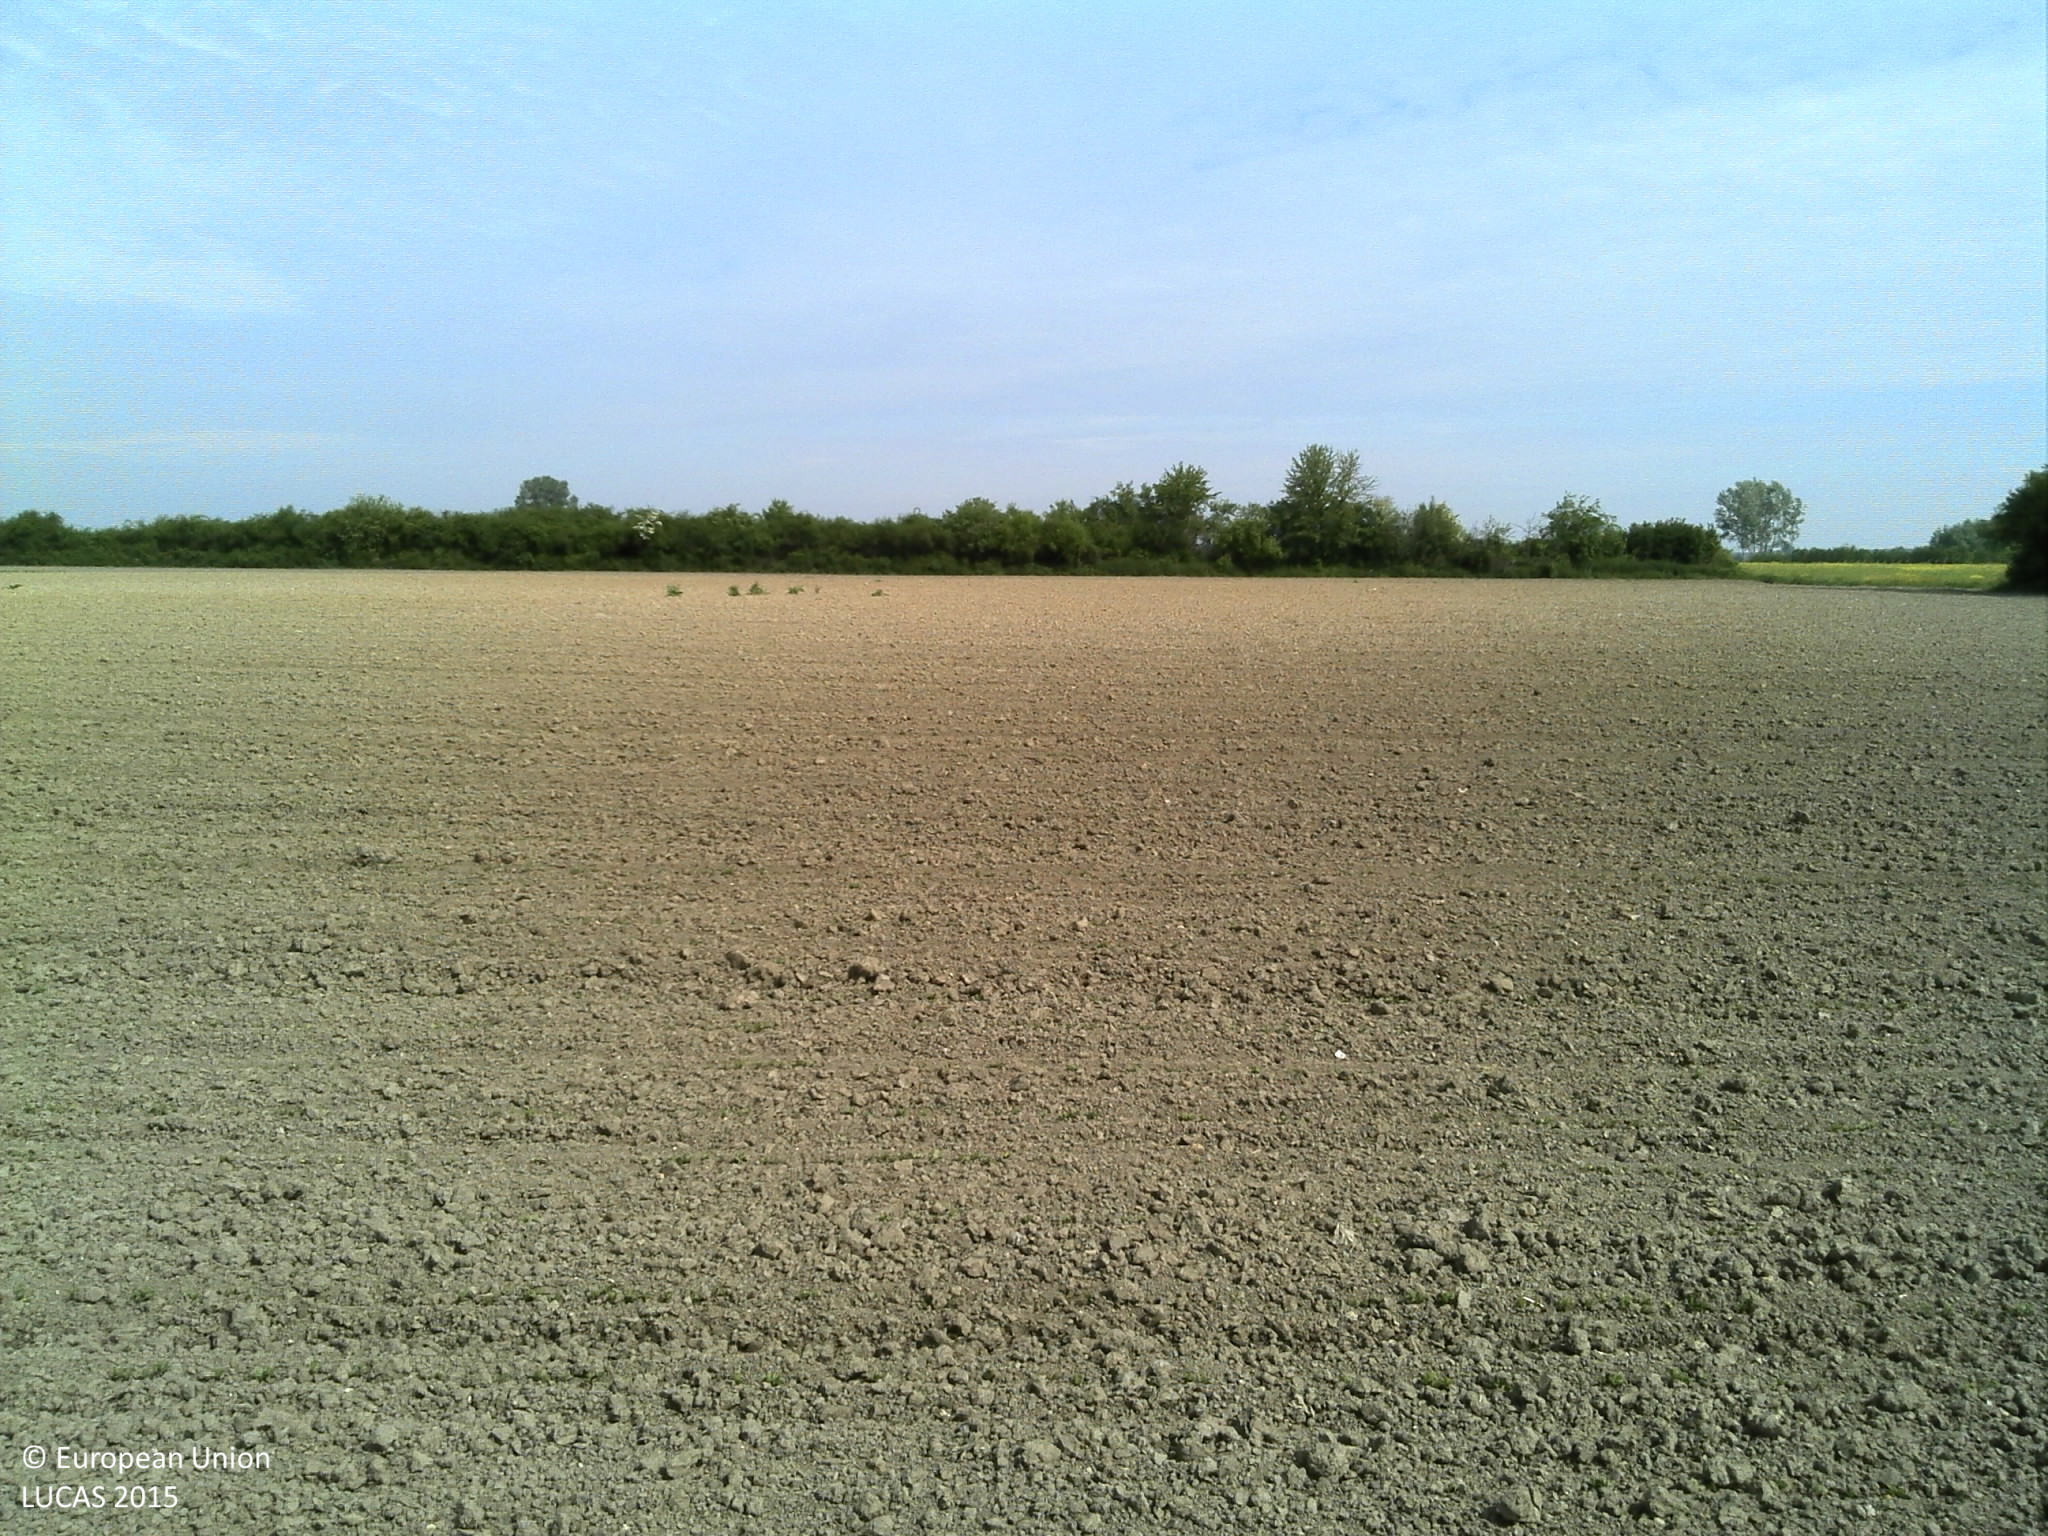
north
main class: Cropland
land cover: Soya
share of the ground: < 10 %
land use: Agriculture (excluding fallow land and kitchen gardens)
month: April
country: HR
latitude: 44.9610
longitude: 18.9440
